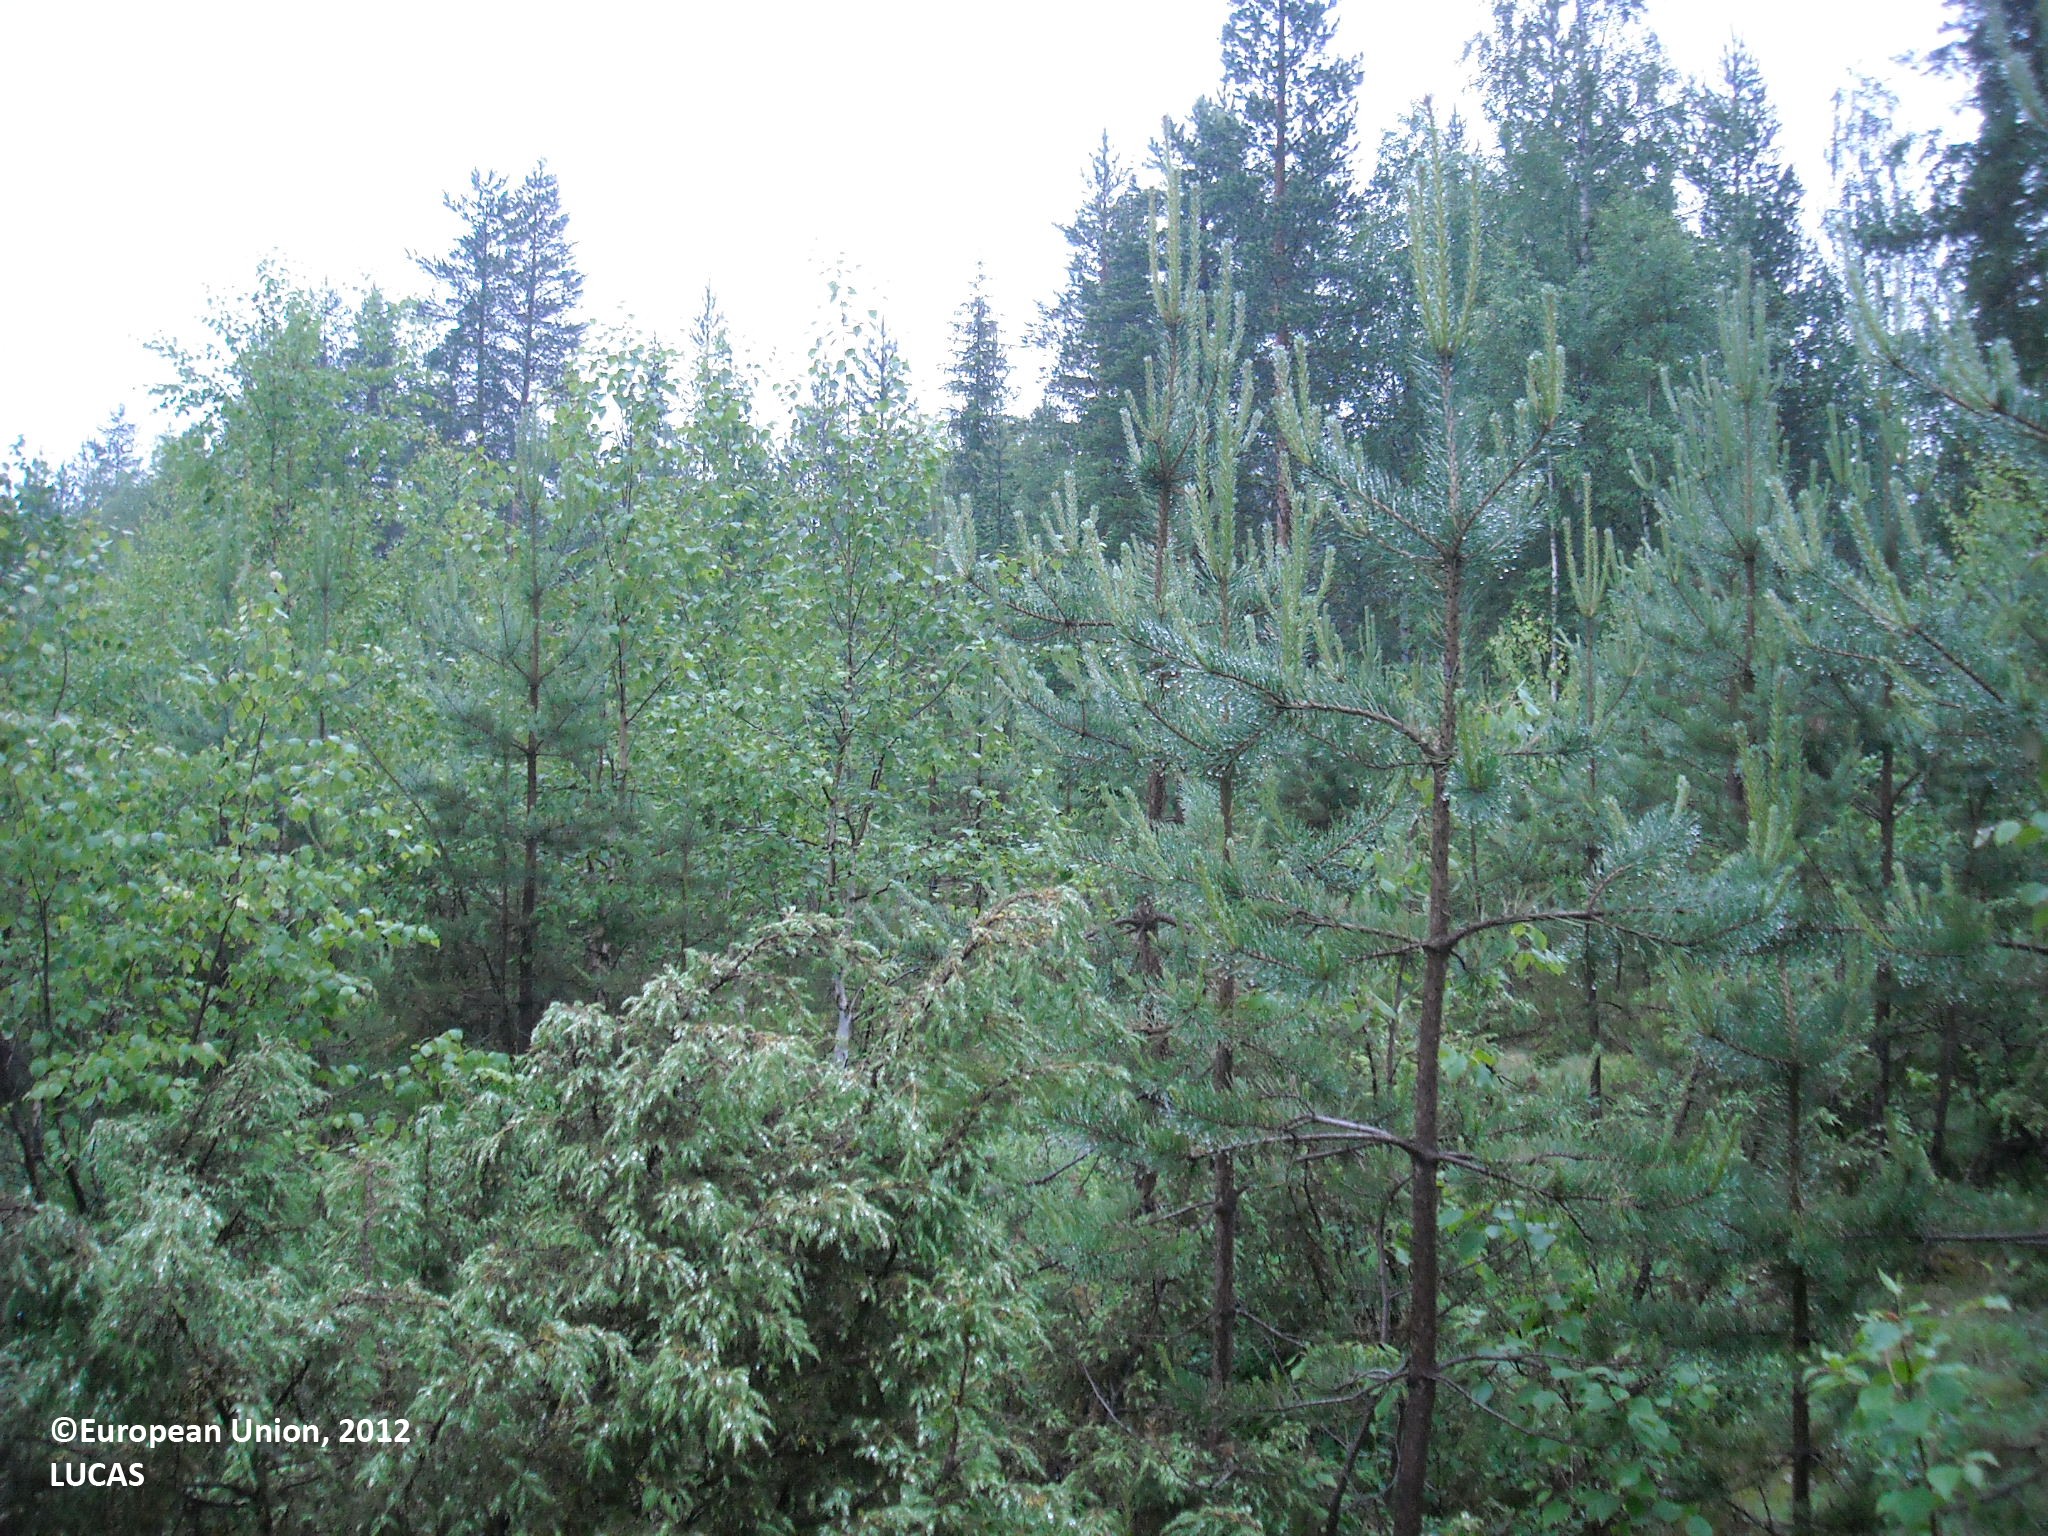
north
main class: Woodland
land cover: Pine dominated mixed woodland
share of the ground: > 75 %
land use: Forestry
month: July
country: FI
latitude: 64.5900
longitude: 27.6285
